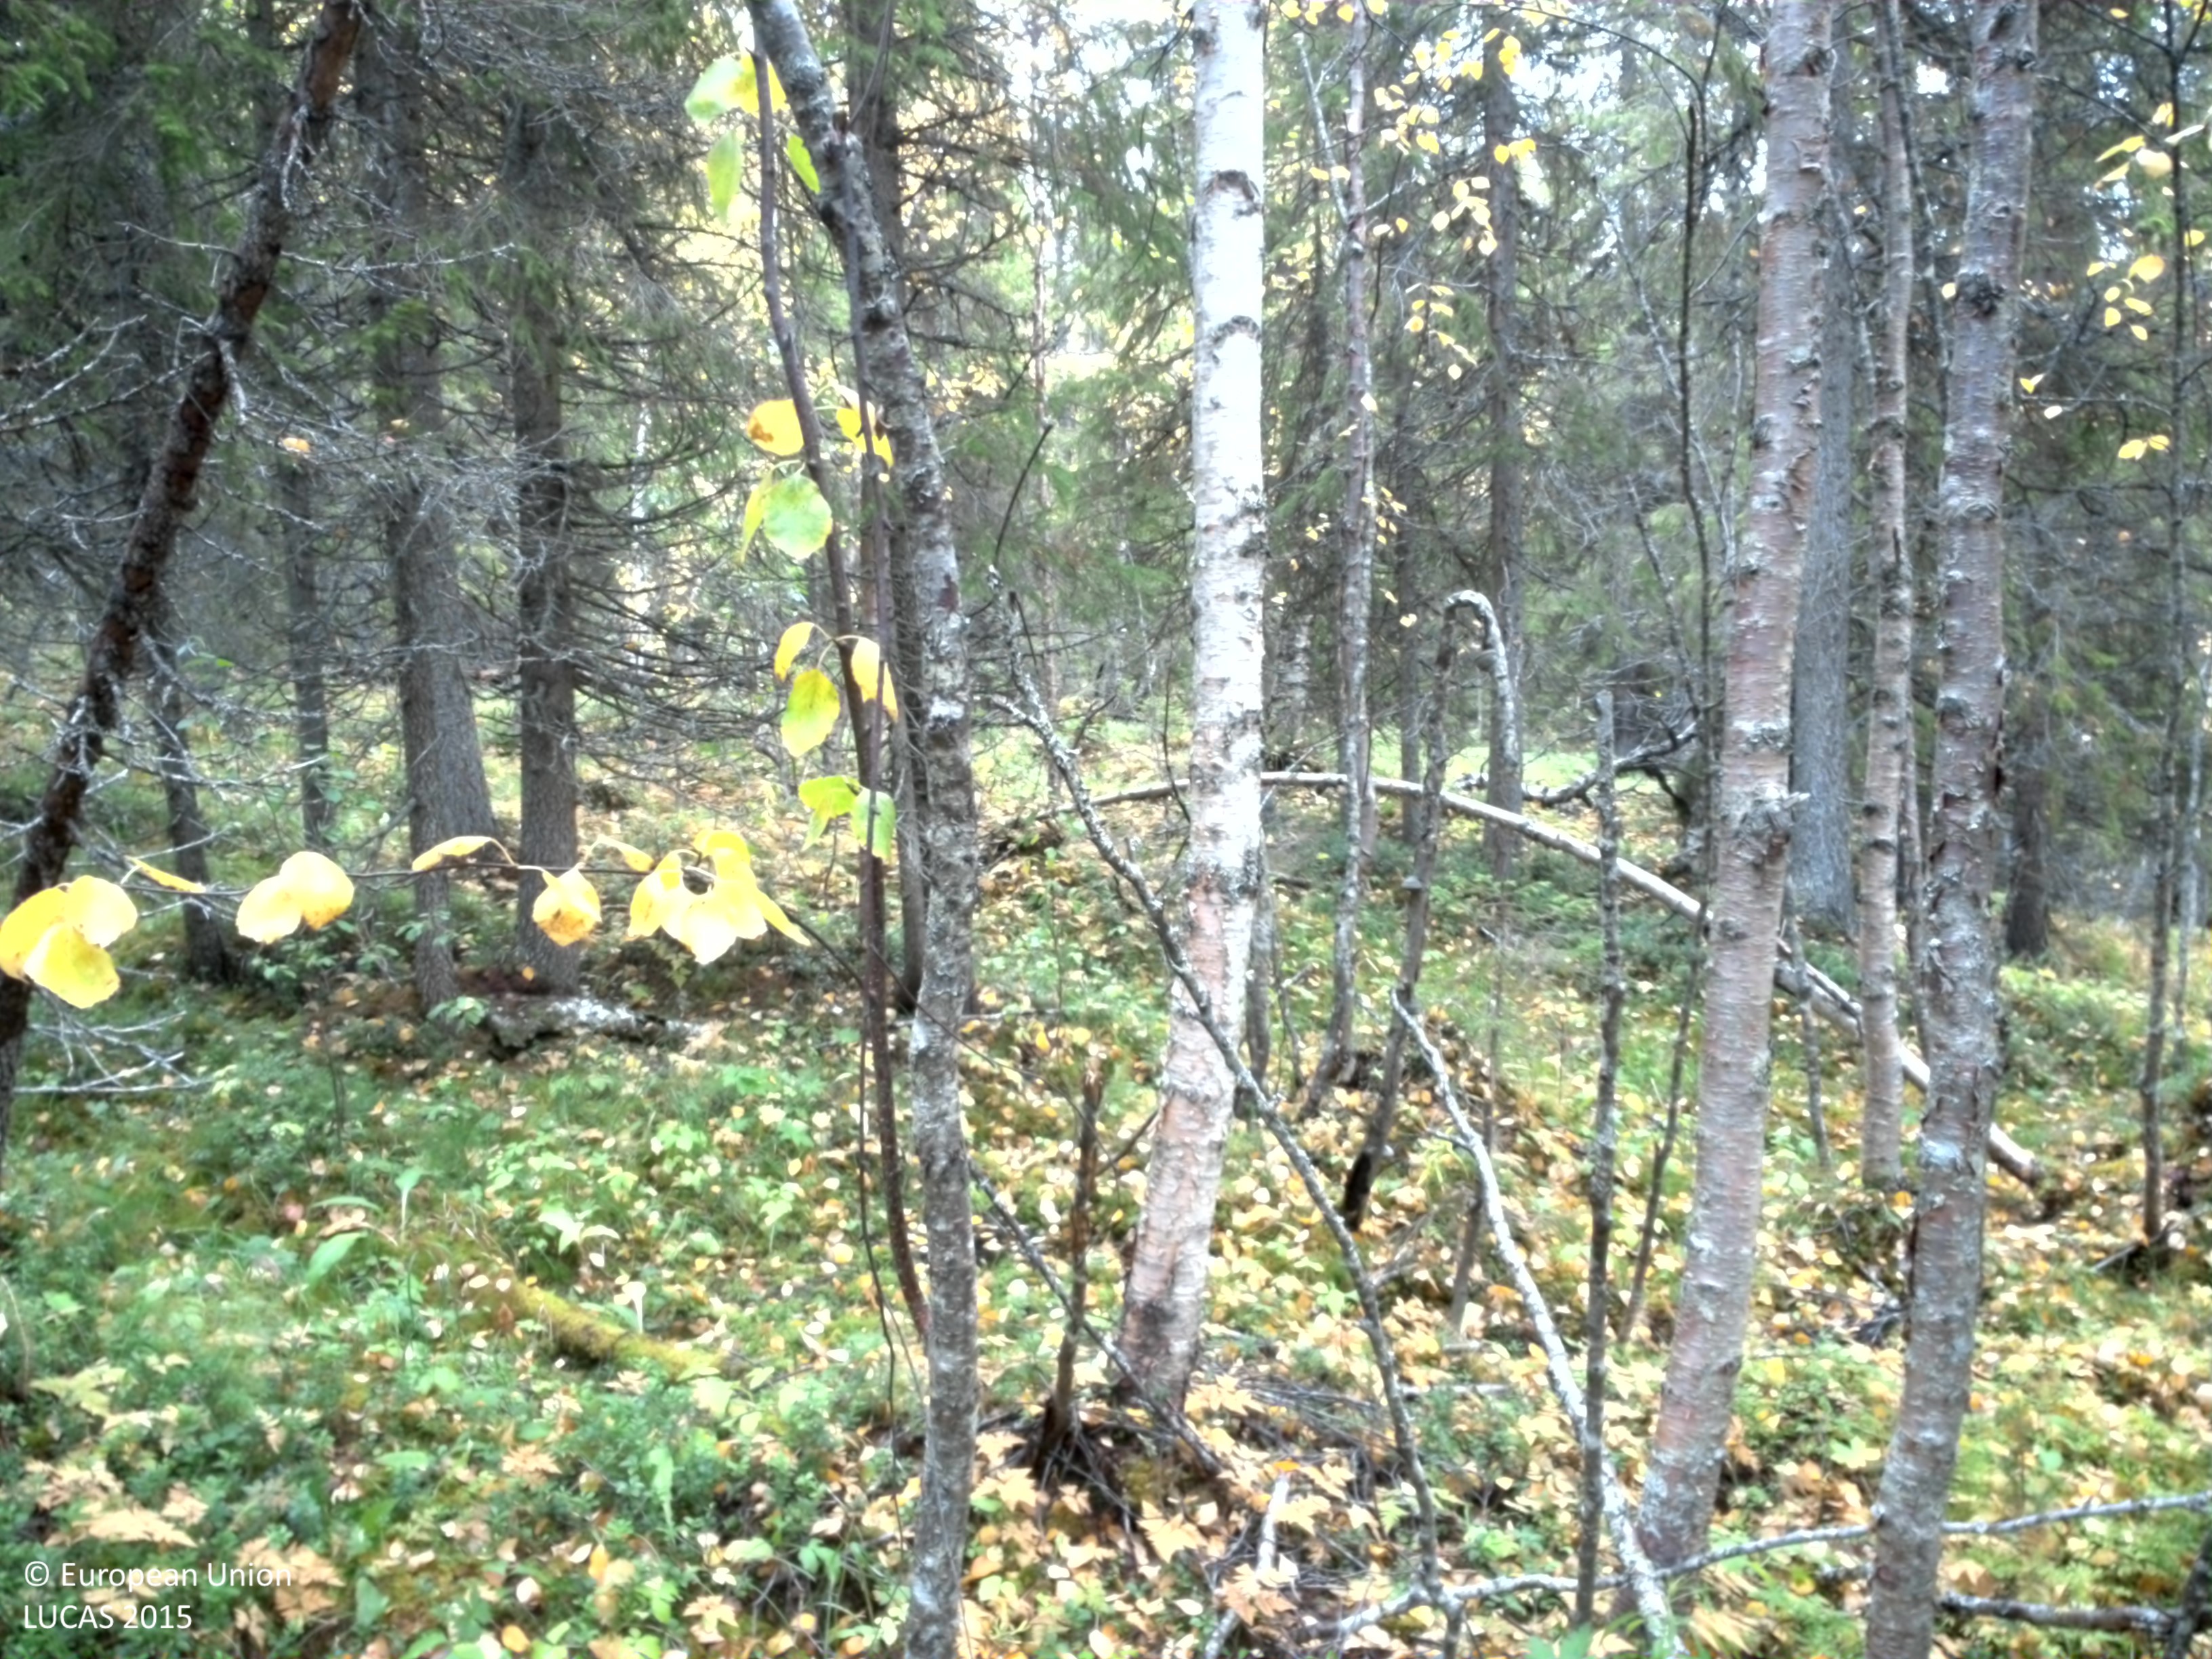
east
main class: Woodland
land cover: Spruce dominated mixed woodland
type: boreal forest
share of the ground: 50 - 75 %
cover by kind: coniferous forest trees 35 %, broadleaved forest trees 25 %, herbaceous plants 20 %, shrubs 10 %, lichens and mosses 10 %
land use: Forestry
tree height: > 5 m
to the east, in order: Spruce dominated mixed woodland; Shrubland without tree cover; Grassland with sparse tree/shrub cover; Shrubland with sparse tree cover
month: September
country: SE
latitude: 65.3639
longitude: 16.2194
